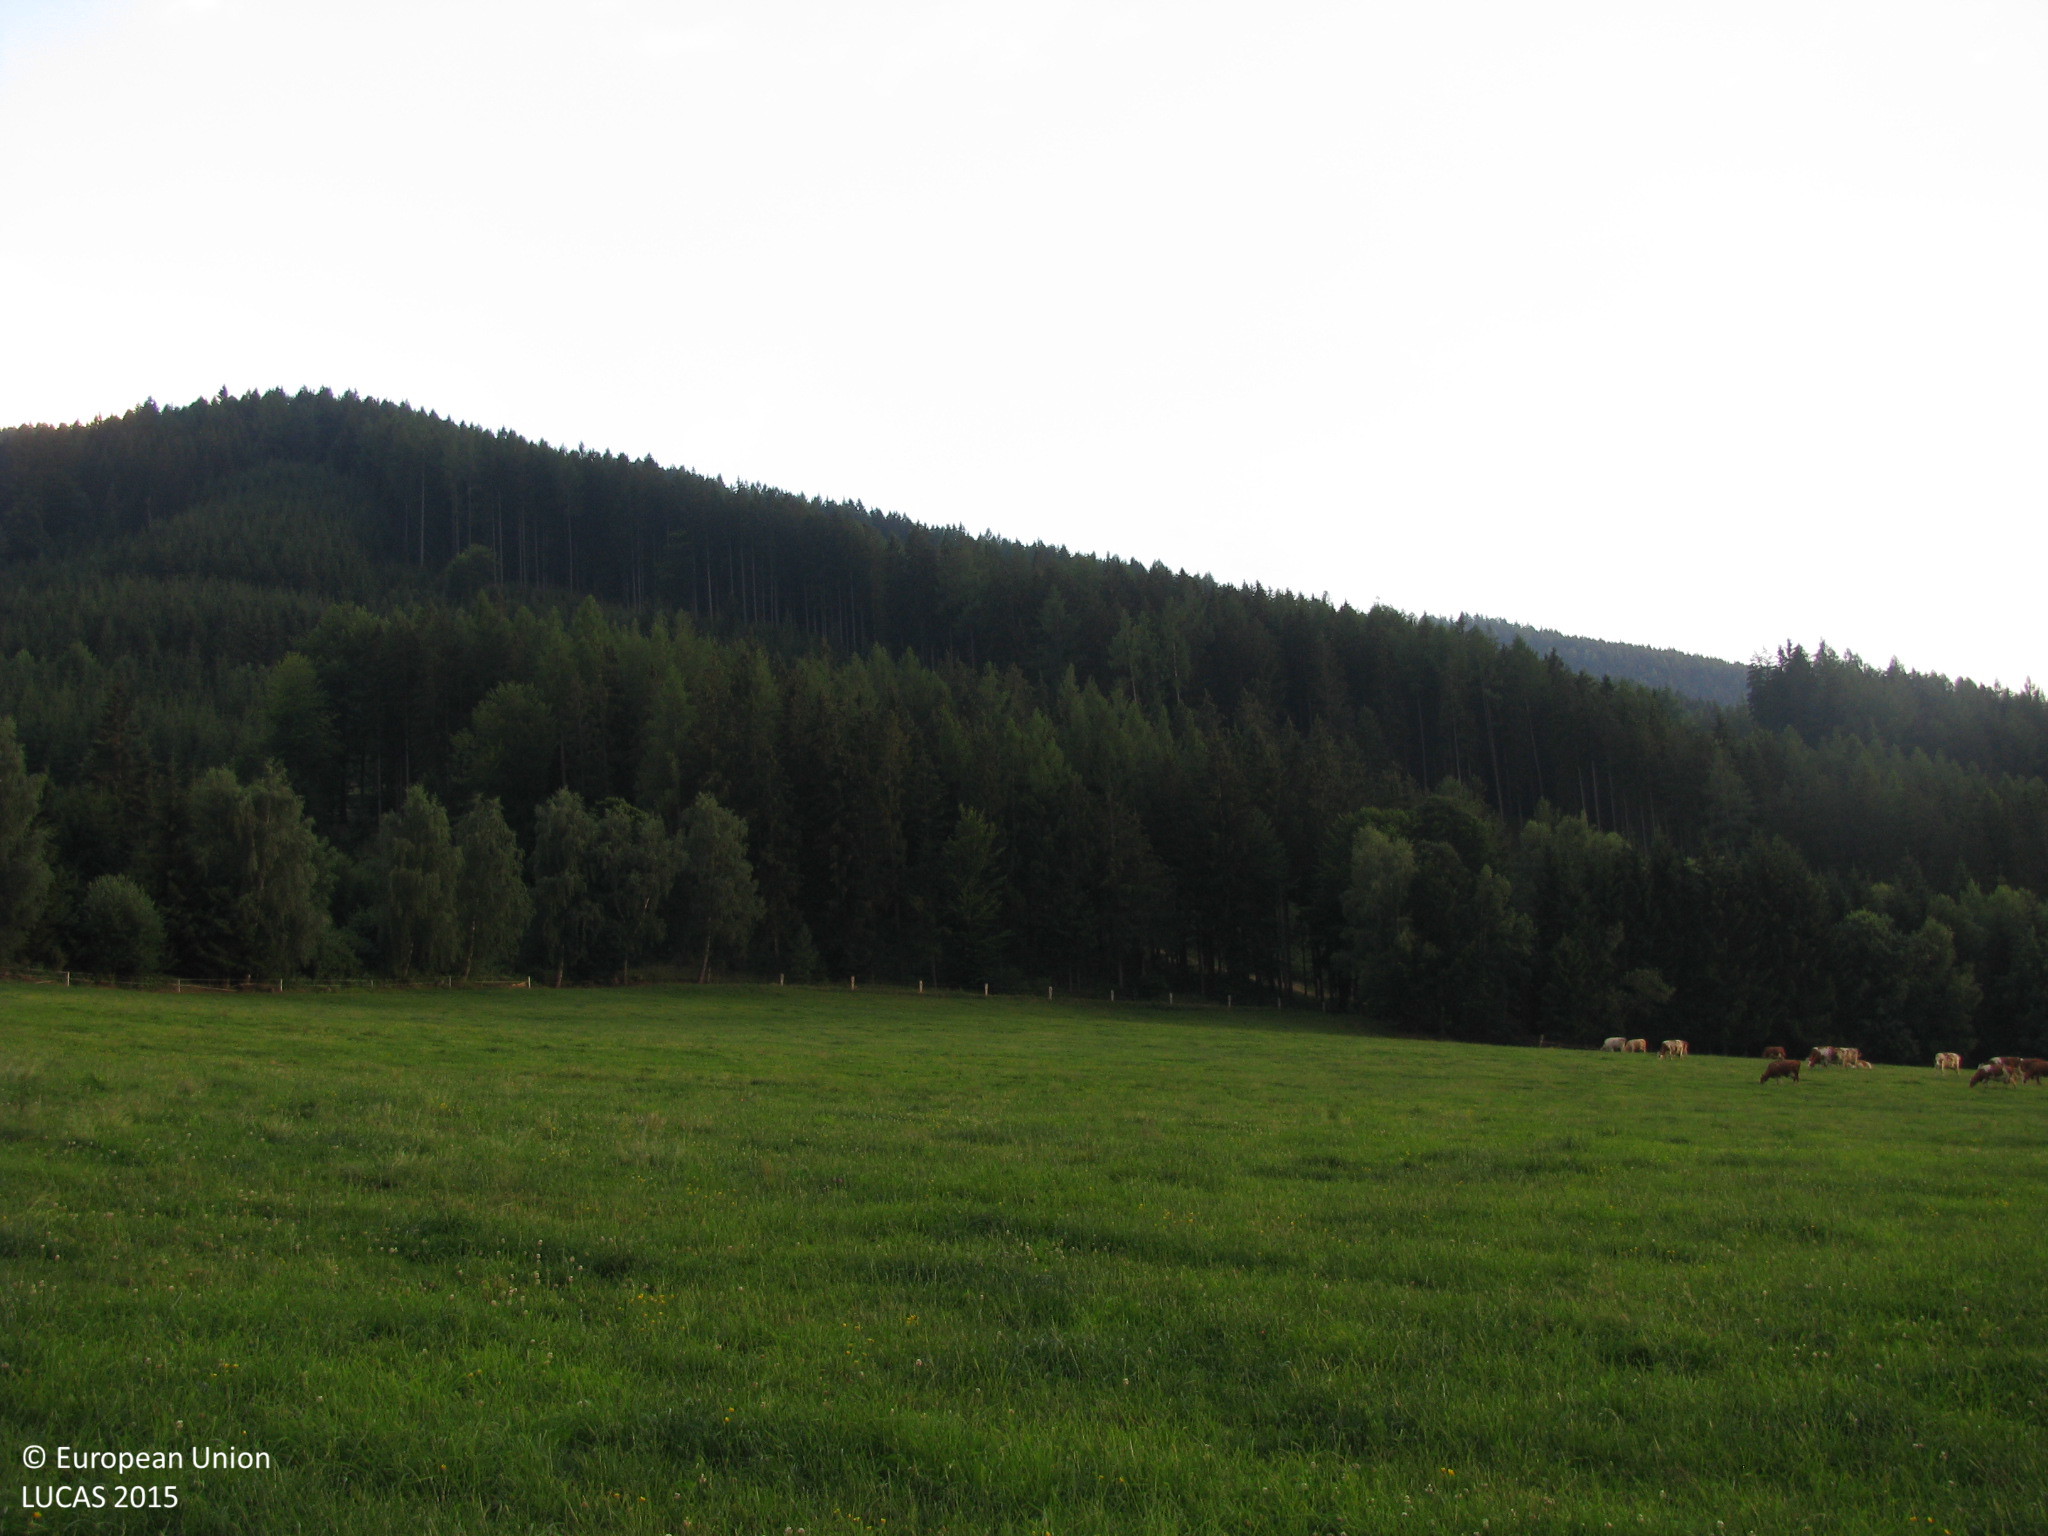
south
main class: Grassland
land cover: Grassland without tree/shrub cover
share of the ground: > 75 %
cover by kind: herbaceous plants 100 %
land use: Agriculture (excluding fallow land and kitchen gardens)
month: July
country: AT
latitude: 47.1292
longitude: 14.7579
